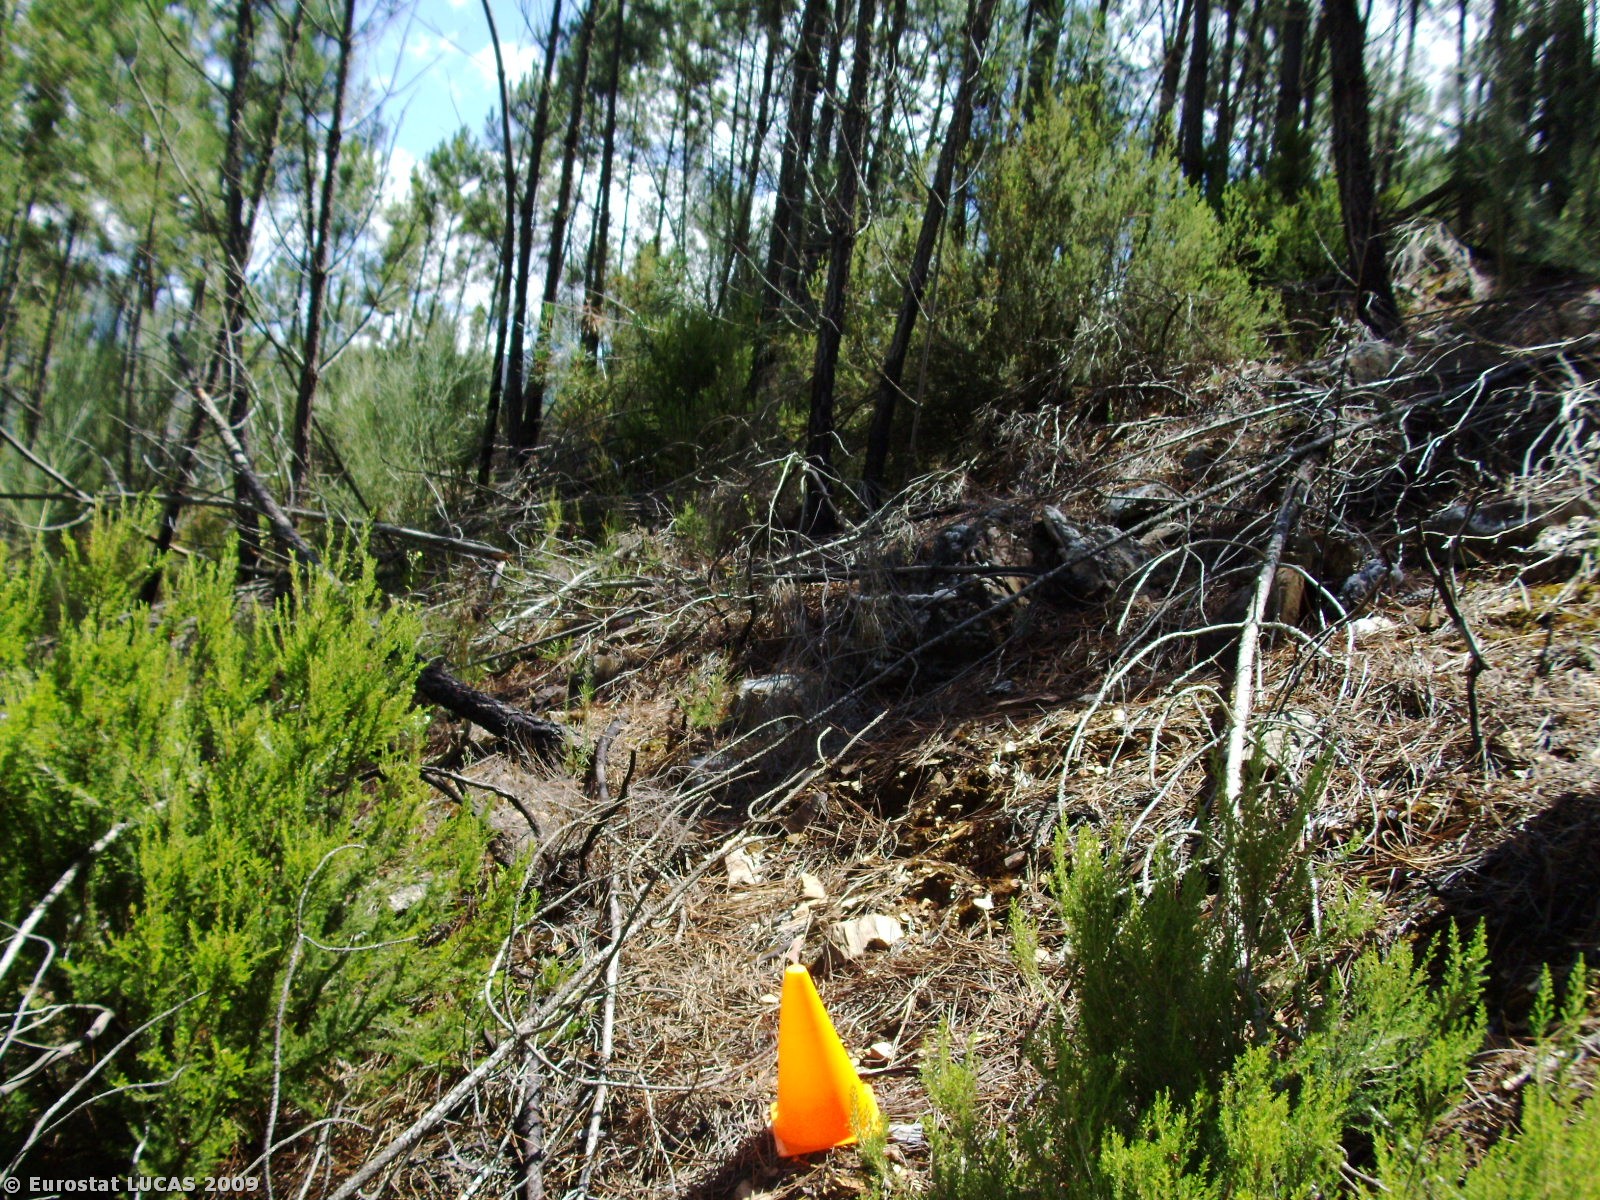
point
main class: Woodland
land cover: Coniferous woodland
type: coniferous forest of the mediterranean region
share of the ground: > 75 %
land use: Forestry
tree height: > 5 m
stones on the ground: 25 - 50 %
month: June
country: PT
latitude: 40.2832
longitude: -7.7206
